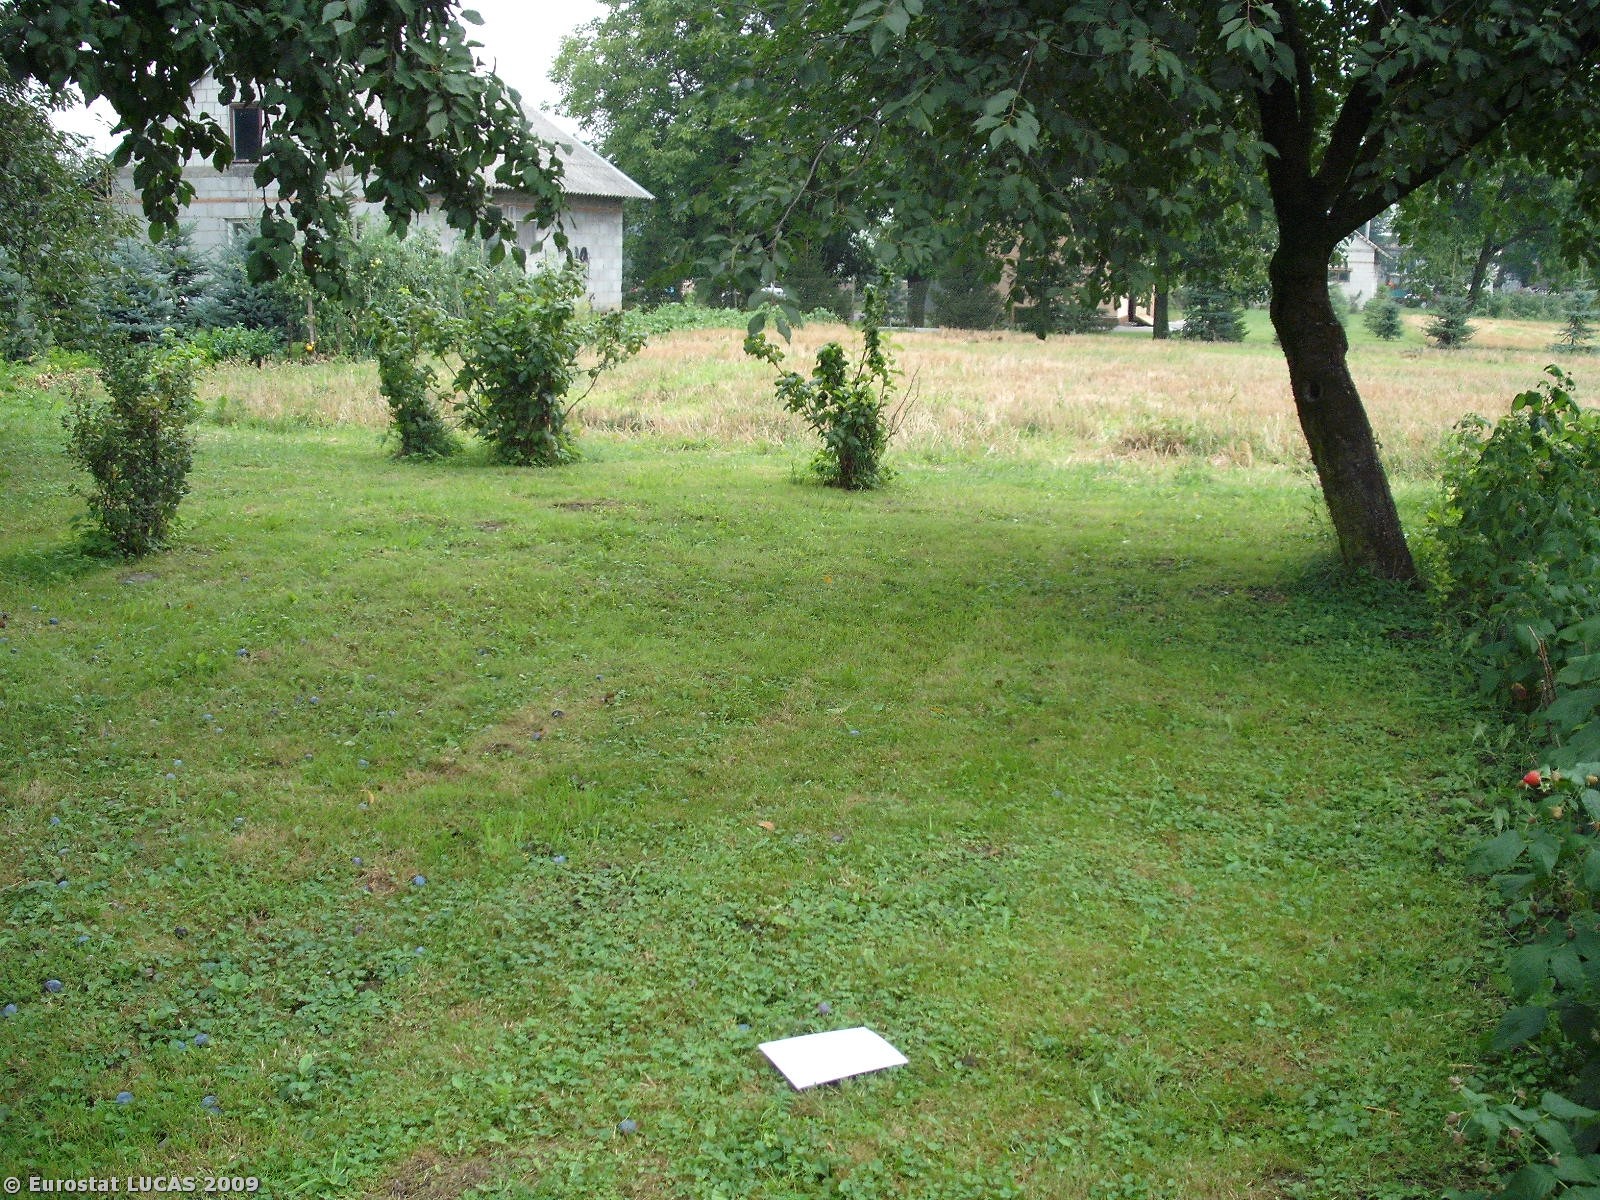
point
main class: Cropland
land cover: Other fruit trees and berries
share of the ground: > 75 %
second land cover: Grassland with sparse tree/shrub cover
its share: > 75 %
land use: Kitchen garden
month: August
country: PL
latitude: 50.0292
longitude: 22.5885
